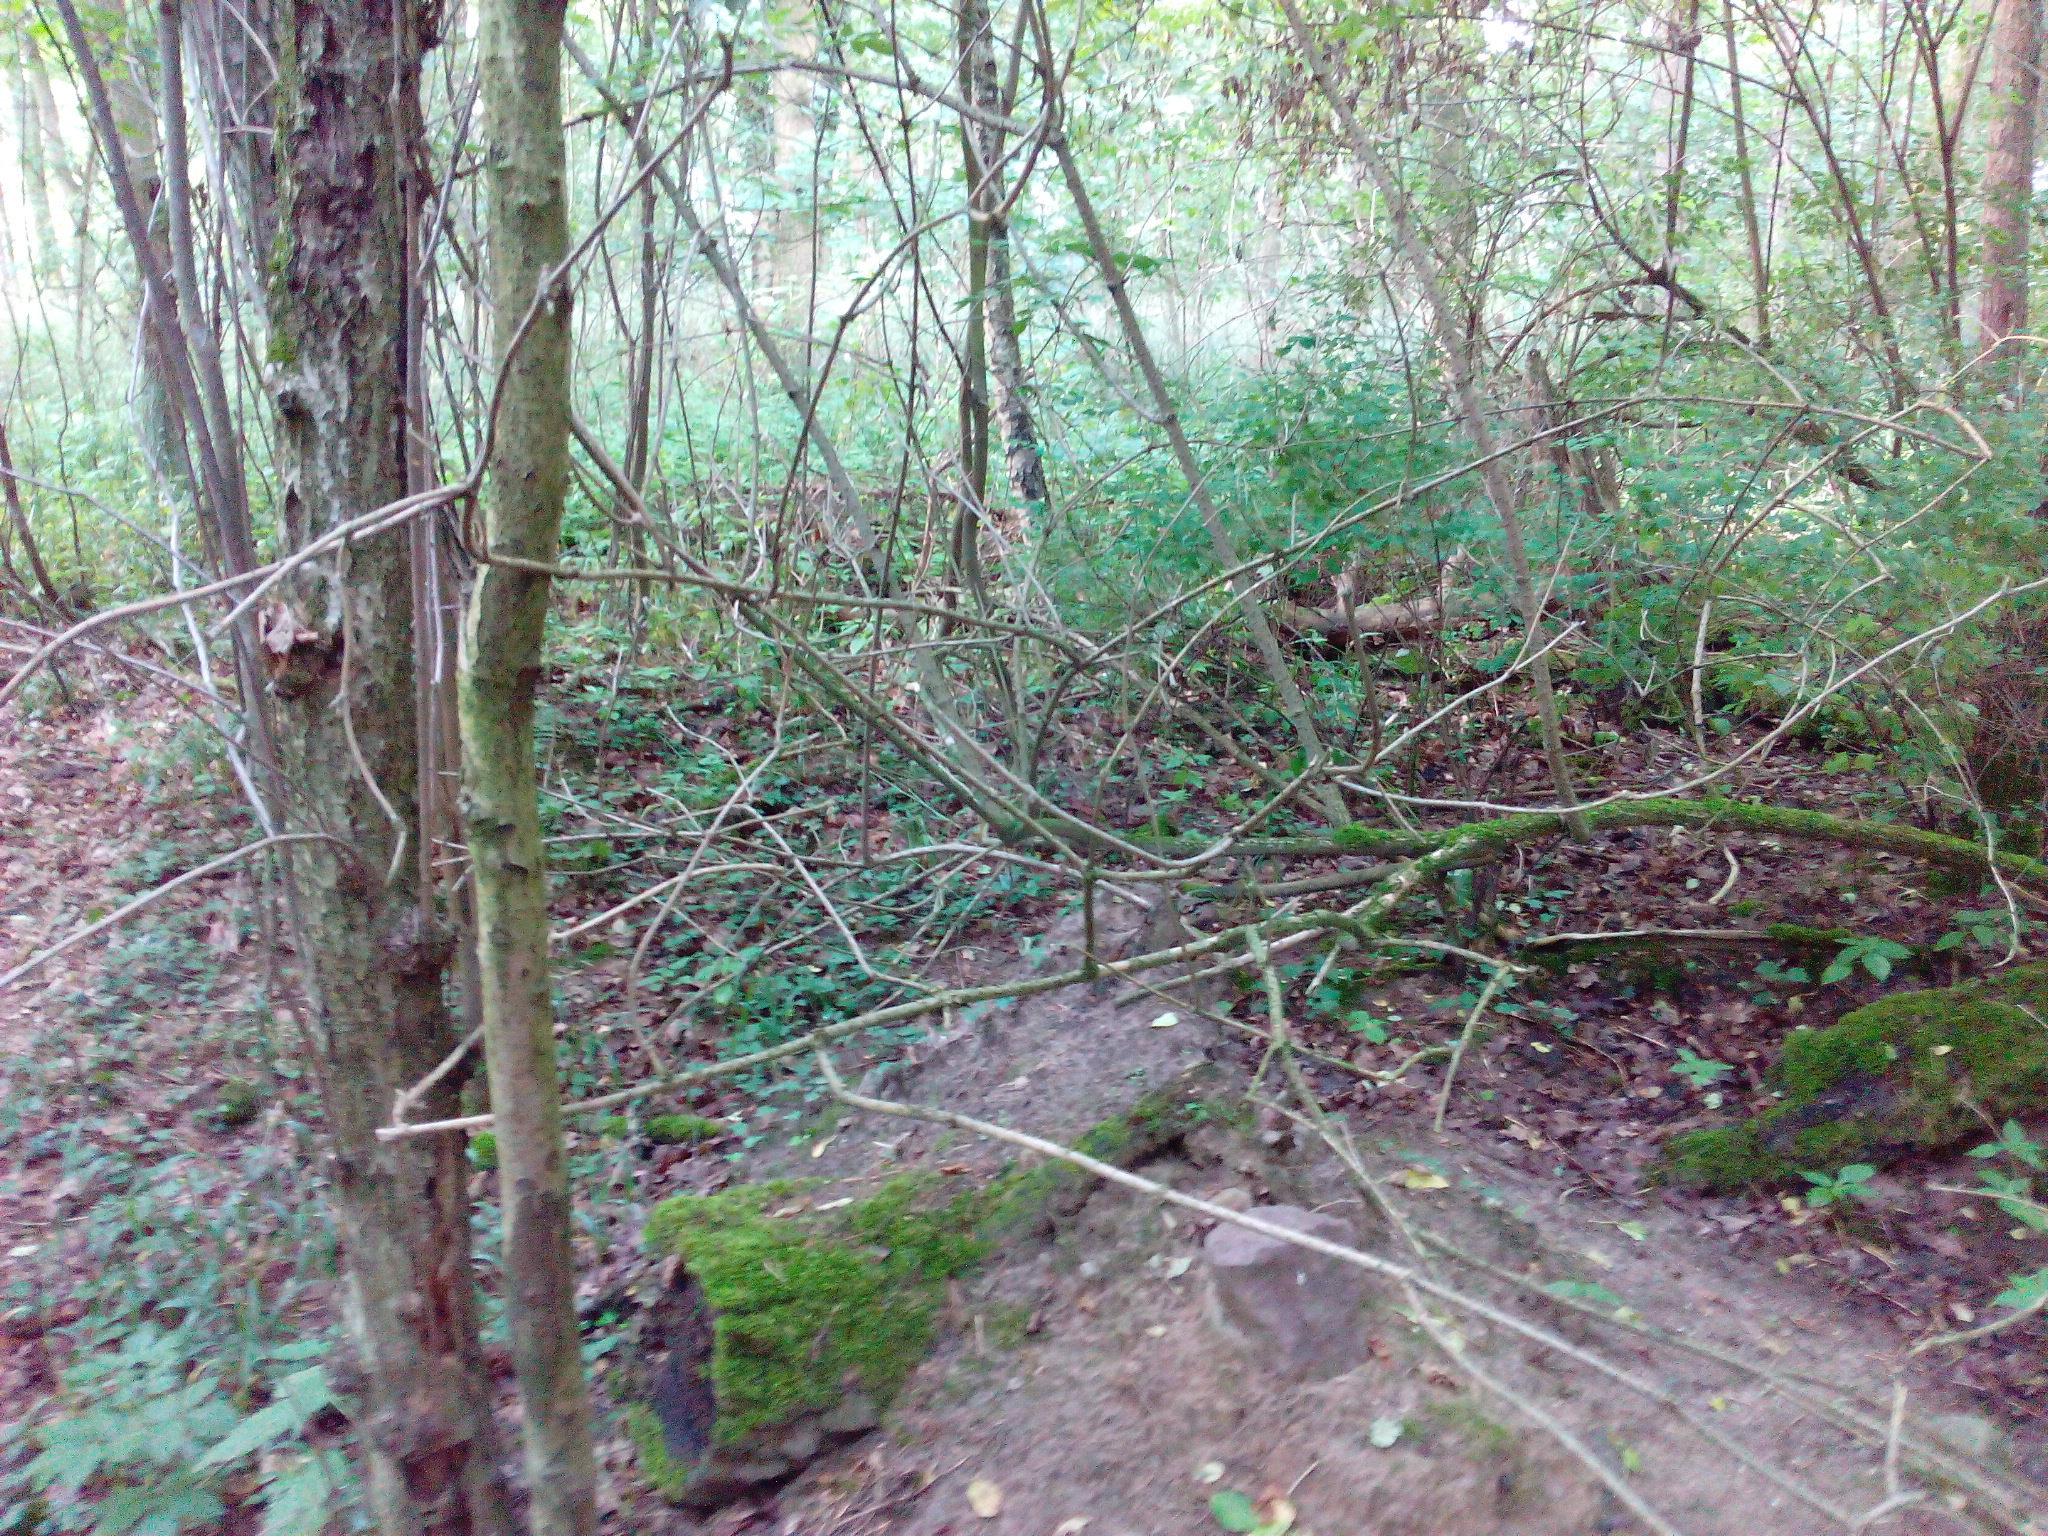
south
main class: Woodland
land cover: Other mixed woodland
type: hemiboreal forest and nemoral coniferous forest and mixed broadleaved-coniferous forest
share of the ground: > 75 %
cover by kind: broadleaved forest trees 50 %, coniferous forest trees 40 %, shrubs 5 %, herbaceous plants 5 %
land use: Forestry
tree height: > 5 m
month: July
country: DE
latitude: 53.1860
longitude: 14.1760
